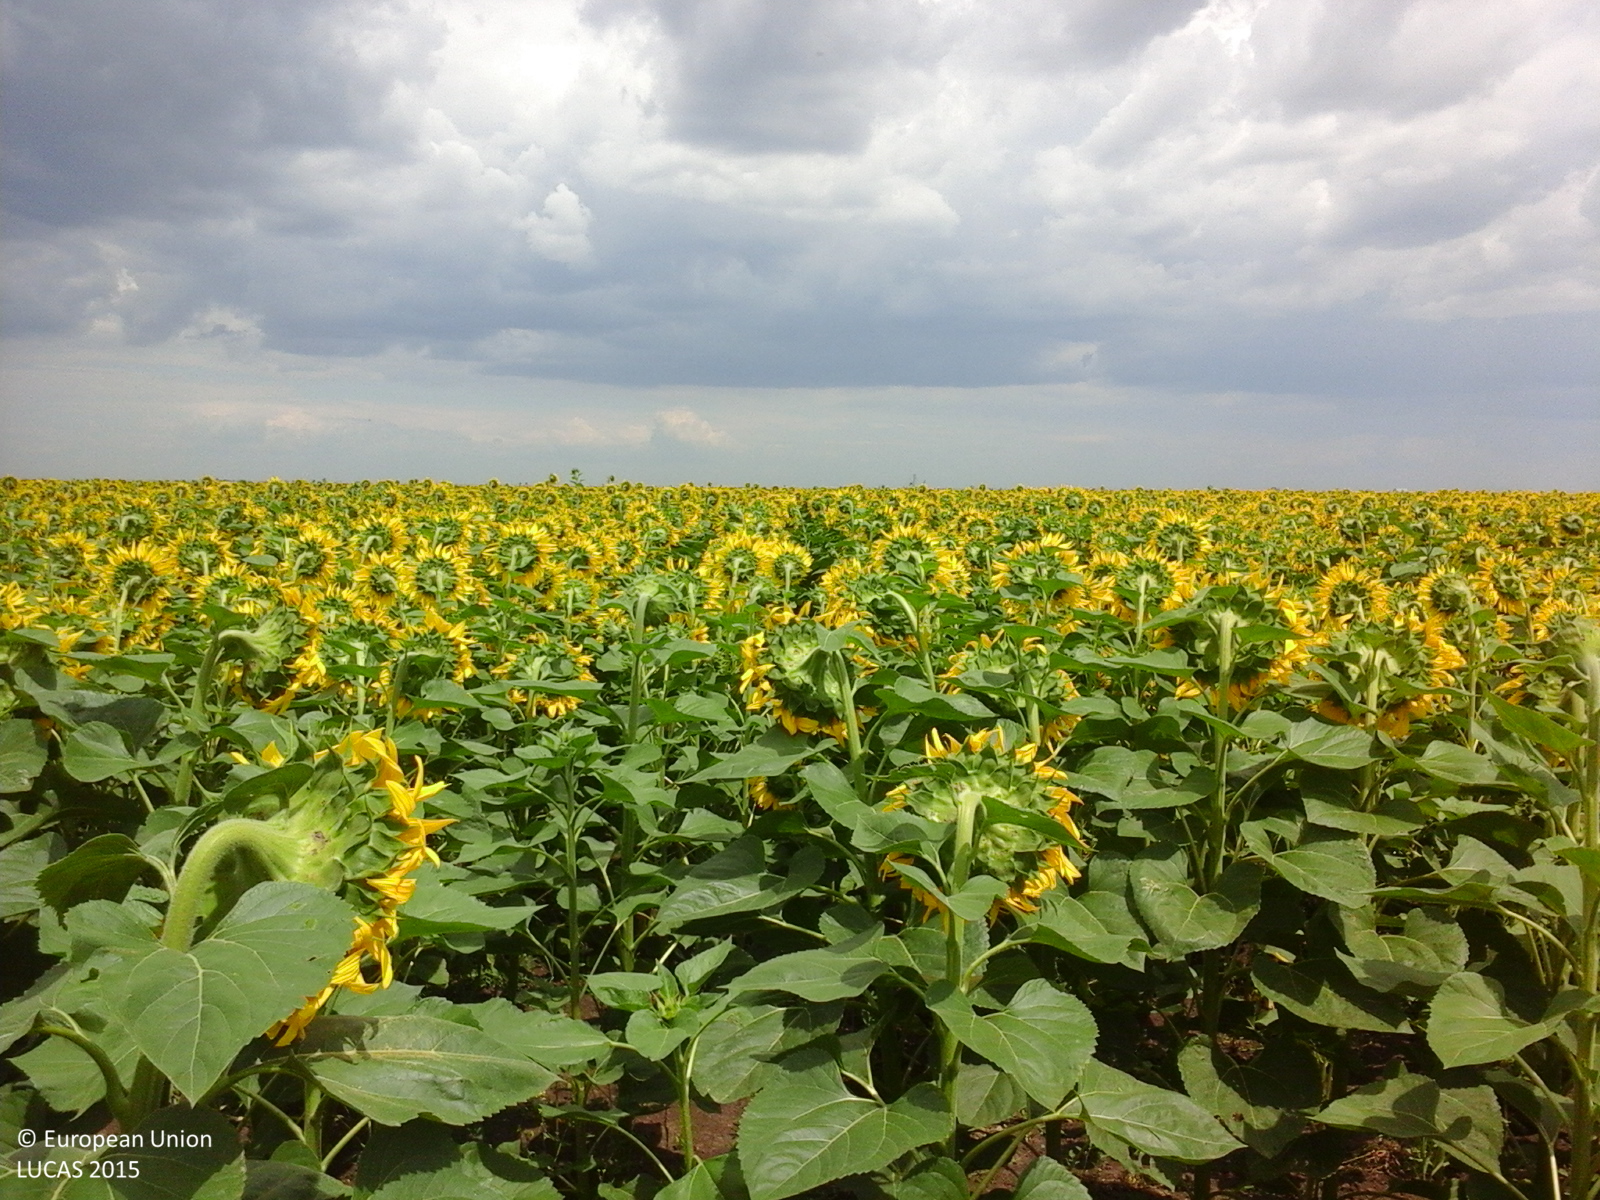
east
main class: Cropland
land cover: Sunflower
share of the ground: > 75 %
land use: Agriculture (excluding fallow land and kitchen gardens)
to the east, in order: Sunflower; Grass margins; Common wheat
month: July
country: RO
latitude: 44.0389
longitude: 24.8870
